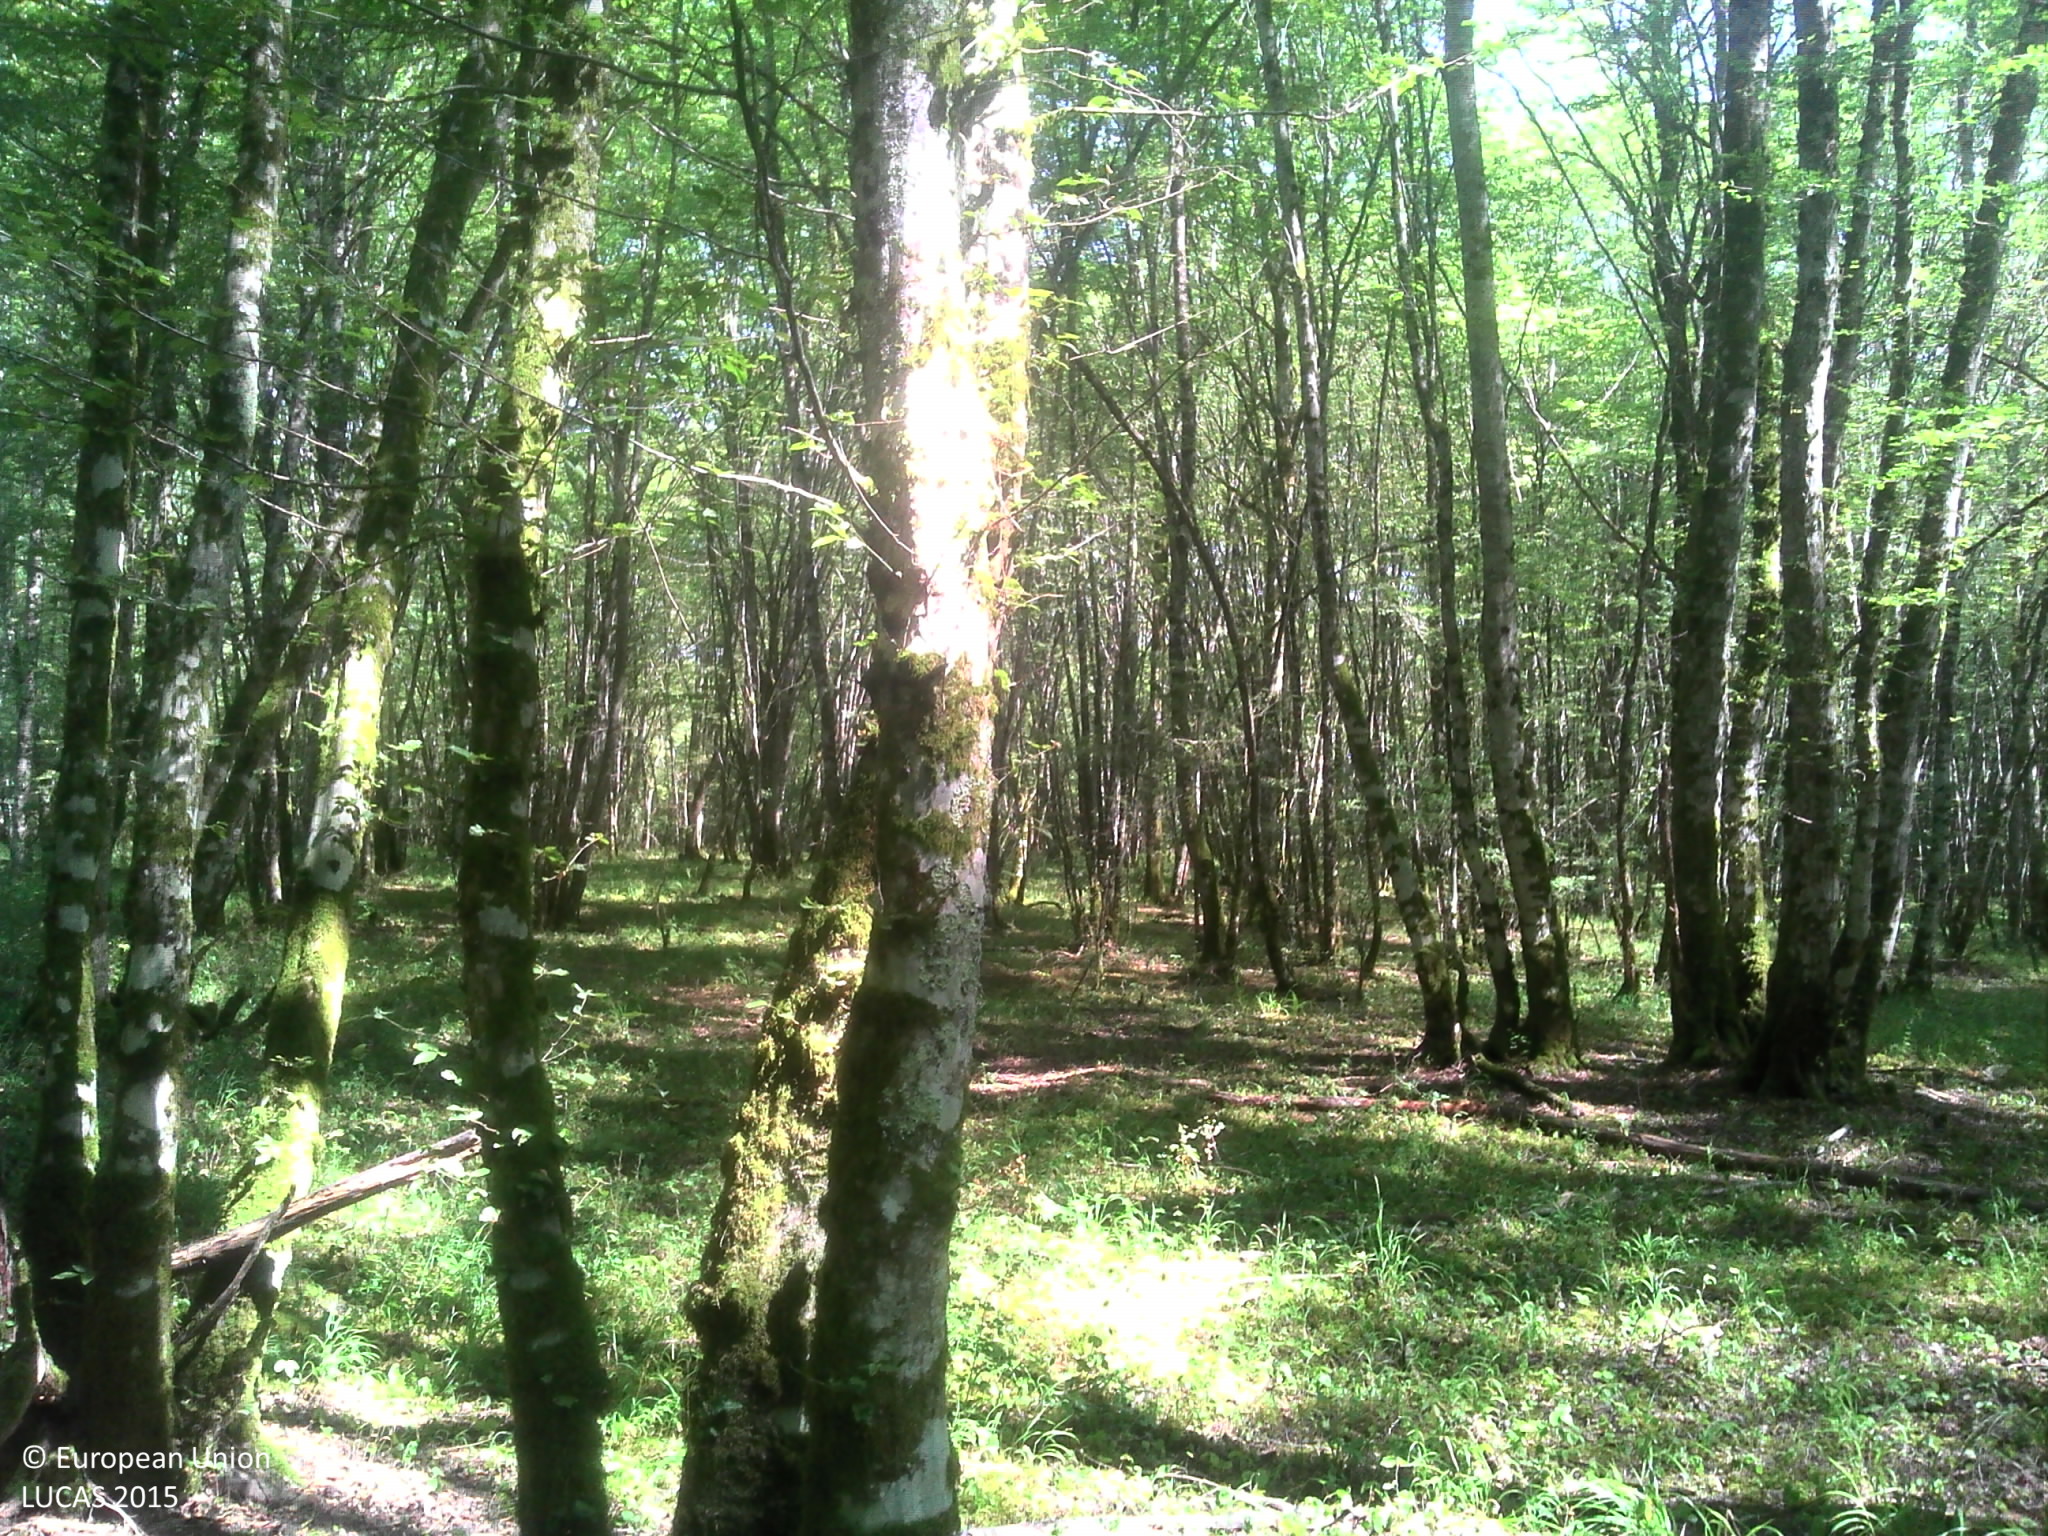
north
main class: Woodland
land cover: Broadleaved woodland
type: beech forest
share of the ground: > 75 %
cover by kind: broadleaved forest trees 80 %, herbaceous plants 10 %, lichens and mosses 10 %
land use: Forestry
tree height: > 5 m
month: July
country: FR
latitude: 48.0174
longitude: 4.9445
